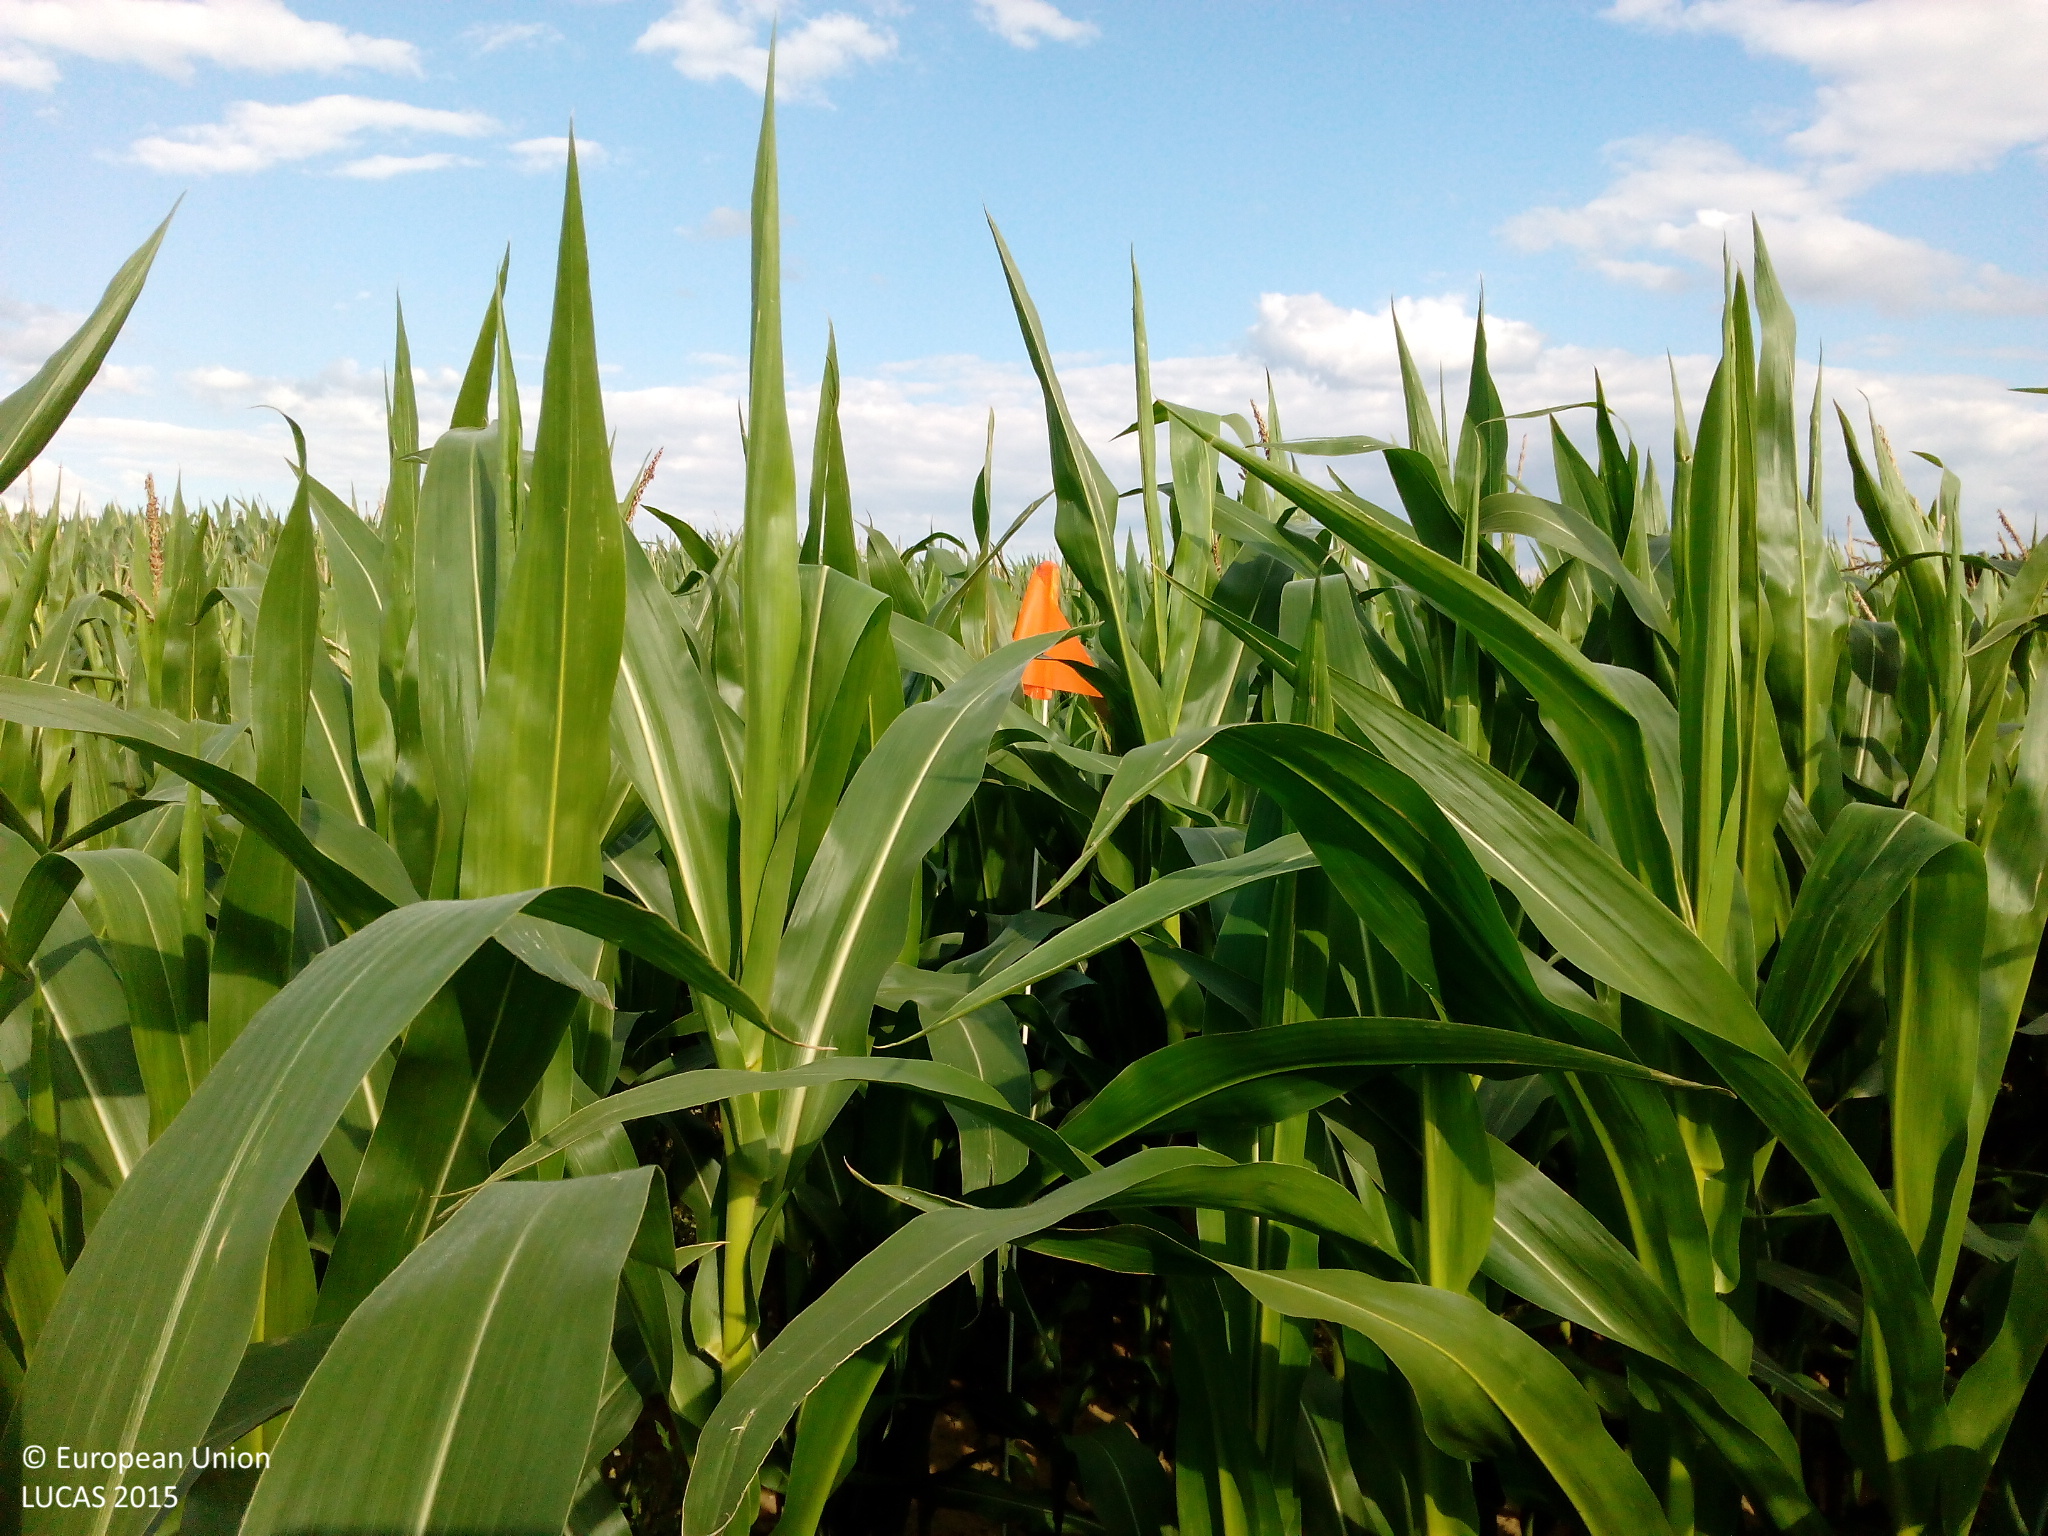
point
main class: Cropland
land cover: Maize
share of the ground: > 75 %
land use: Agriculture (excluding fallow land and kitchen gardens)
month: July
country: DE
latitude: 49.8716
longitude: 12.3789
